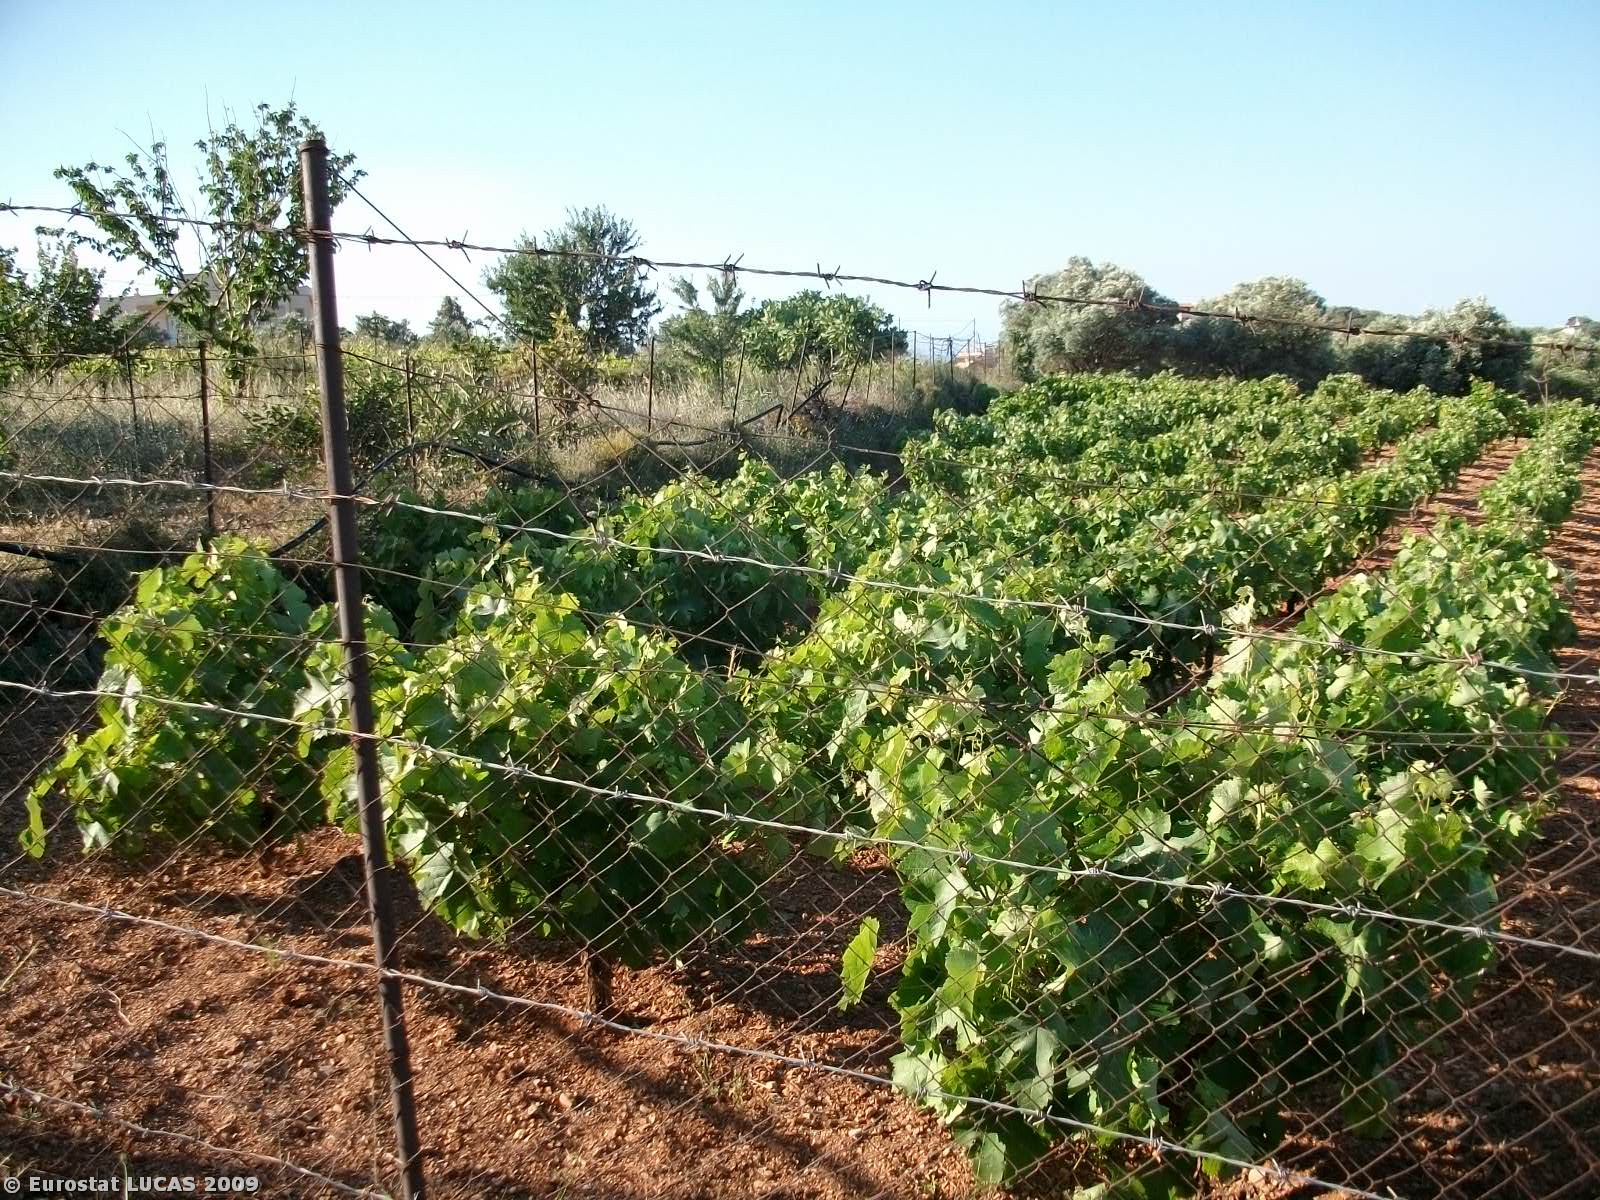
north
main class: Cropland
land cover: Olive groves
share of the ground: > 75 %
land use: Agriculture (excluding fallow land and kitchen gardens)
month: June
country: GR
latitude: 35.3303
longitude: 24.4529
